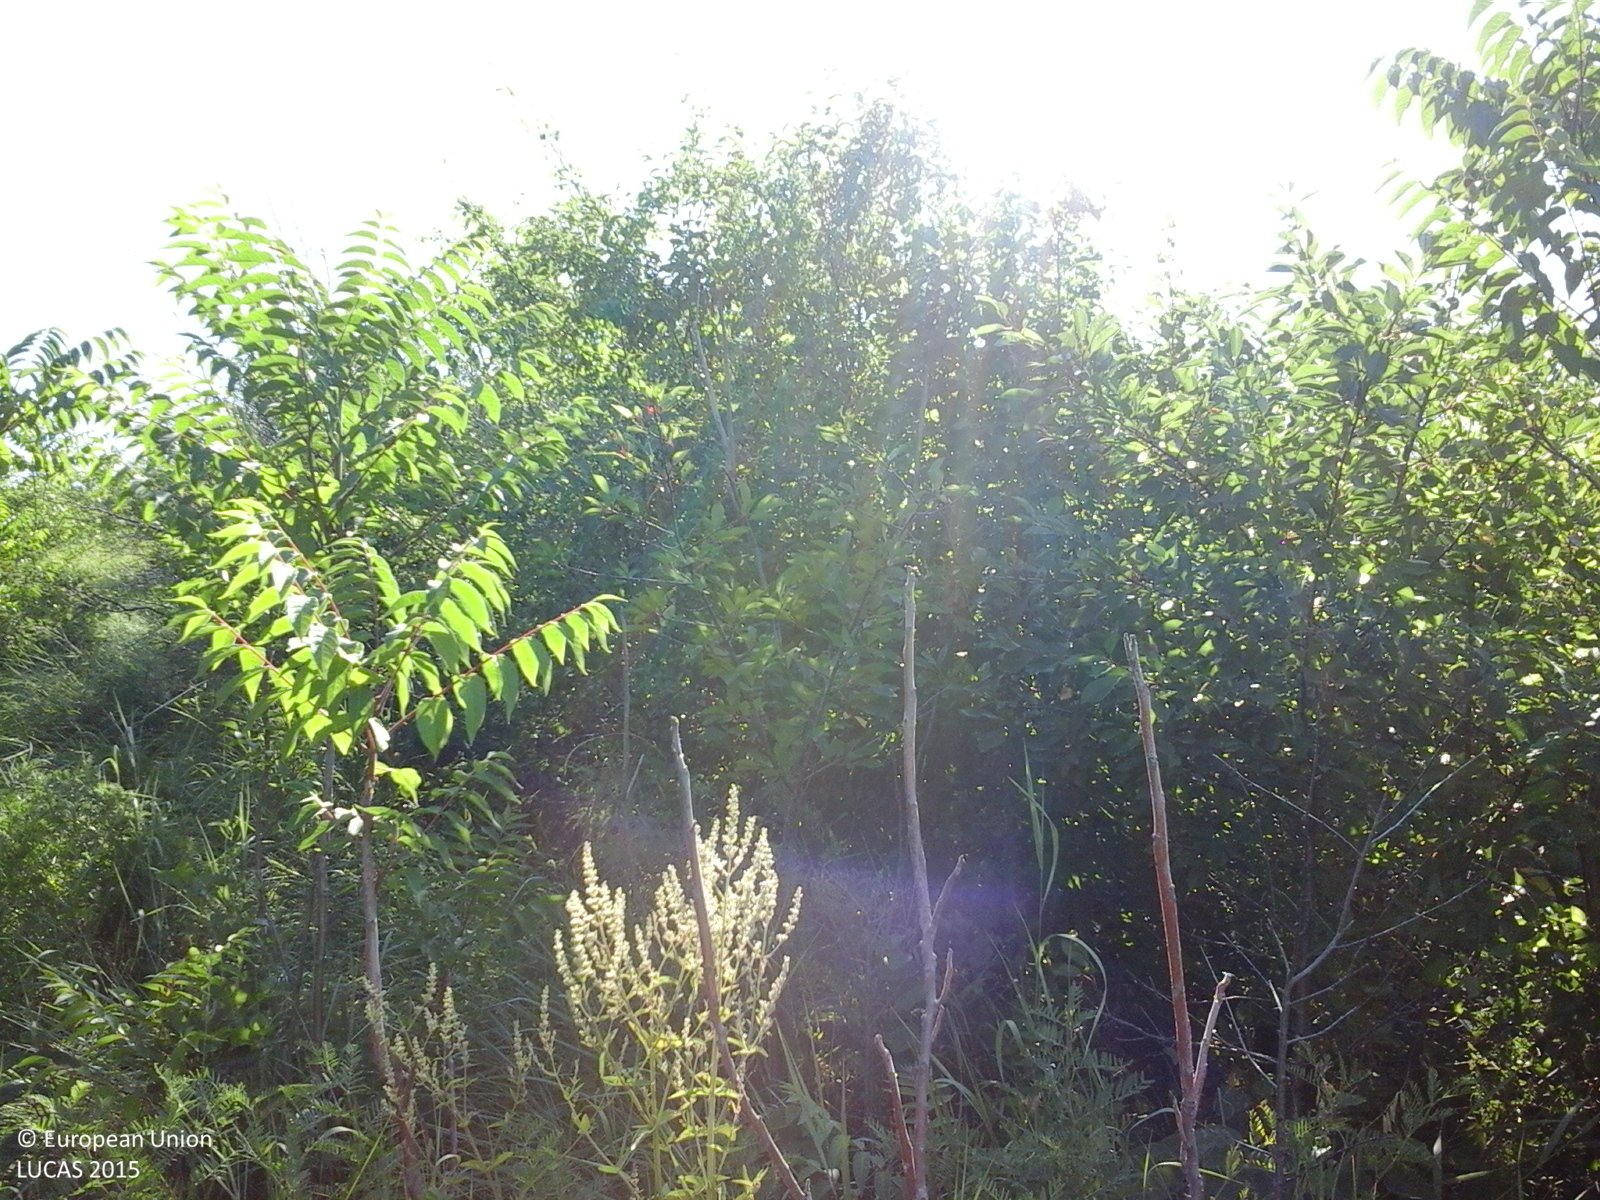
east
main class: Grassland
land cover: Grassland with sparse tree/shrub cover
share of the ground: > 75 %
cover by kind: herbaceous plants 90 %, broadleaved forest trees 5 %, shrubs 5 %
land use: Agriculture (excluding fallow land and kitchen gardens)
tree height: > 5 m
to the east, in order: Grassland with sparse tree/shrub cover; Fences; Shrubland with sparse tree cover; Tracks; Shrubland with sparse tree cover; Grassland without tree/shrub cover; Grassland with sparse tree/shrub cover; Shrubland with sparse tree cover
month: June
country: RO
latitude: 47.1311
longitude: 27.6679
